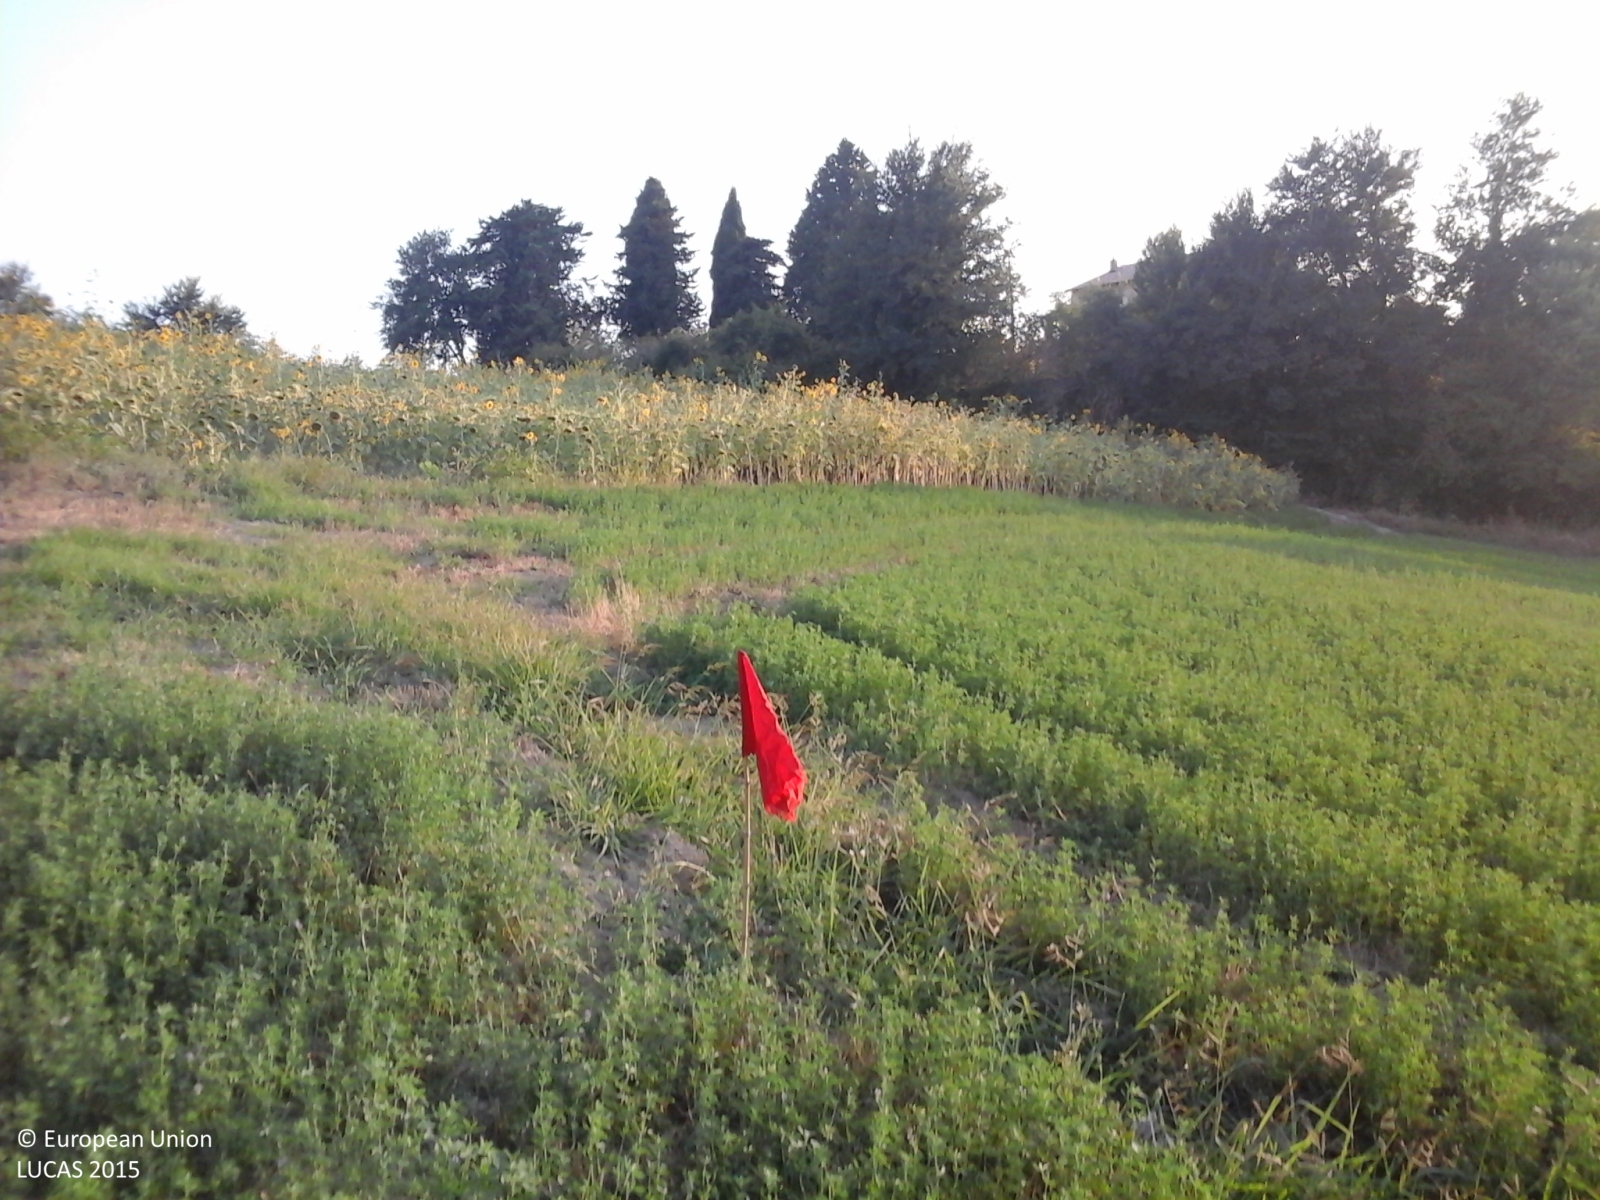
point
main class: Cropland
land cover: Lucerne
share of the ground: > 75 %
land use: Agriculture (excluding fallow land and kitchen gardens)
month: August
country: IT
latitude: 43.1376
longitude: 13.4455
